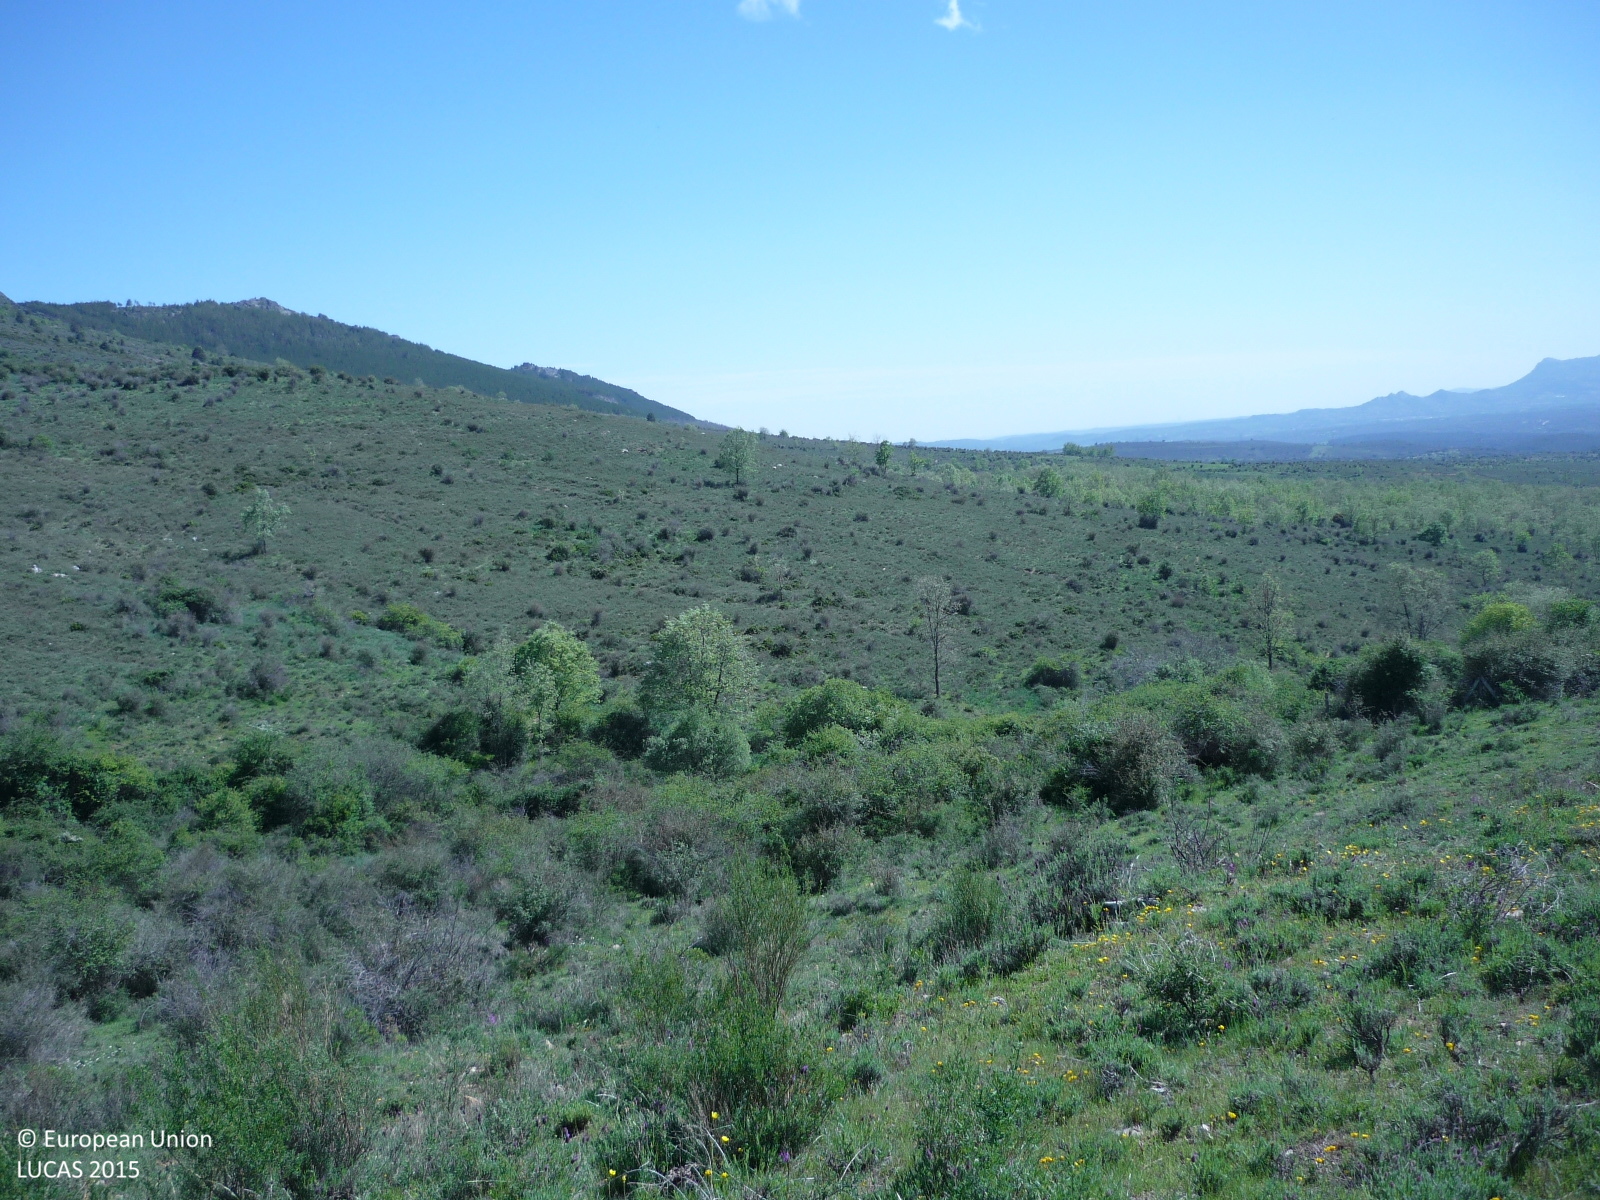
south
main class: Shrubland
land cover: Shrubland without tree cover
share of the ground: 50 - 75 %
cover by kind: shrubs 70 %, unconsolidated bare surface 30 %
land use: Semi-natural and natural areas not in use
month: May
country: ES
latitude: 41.0119
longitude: -3.5146
